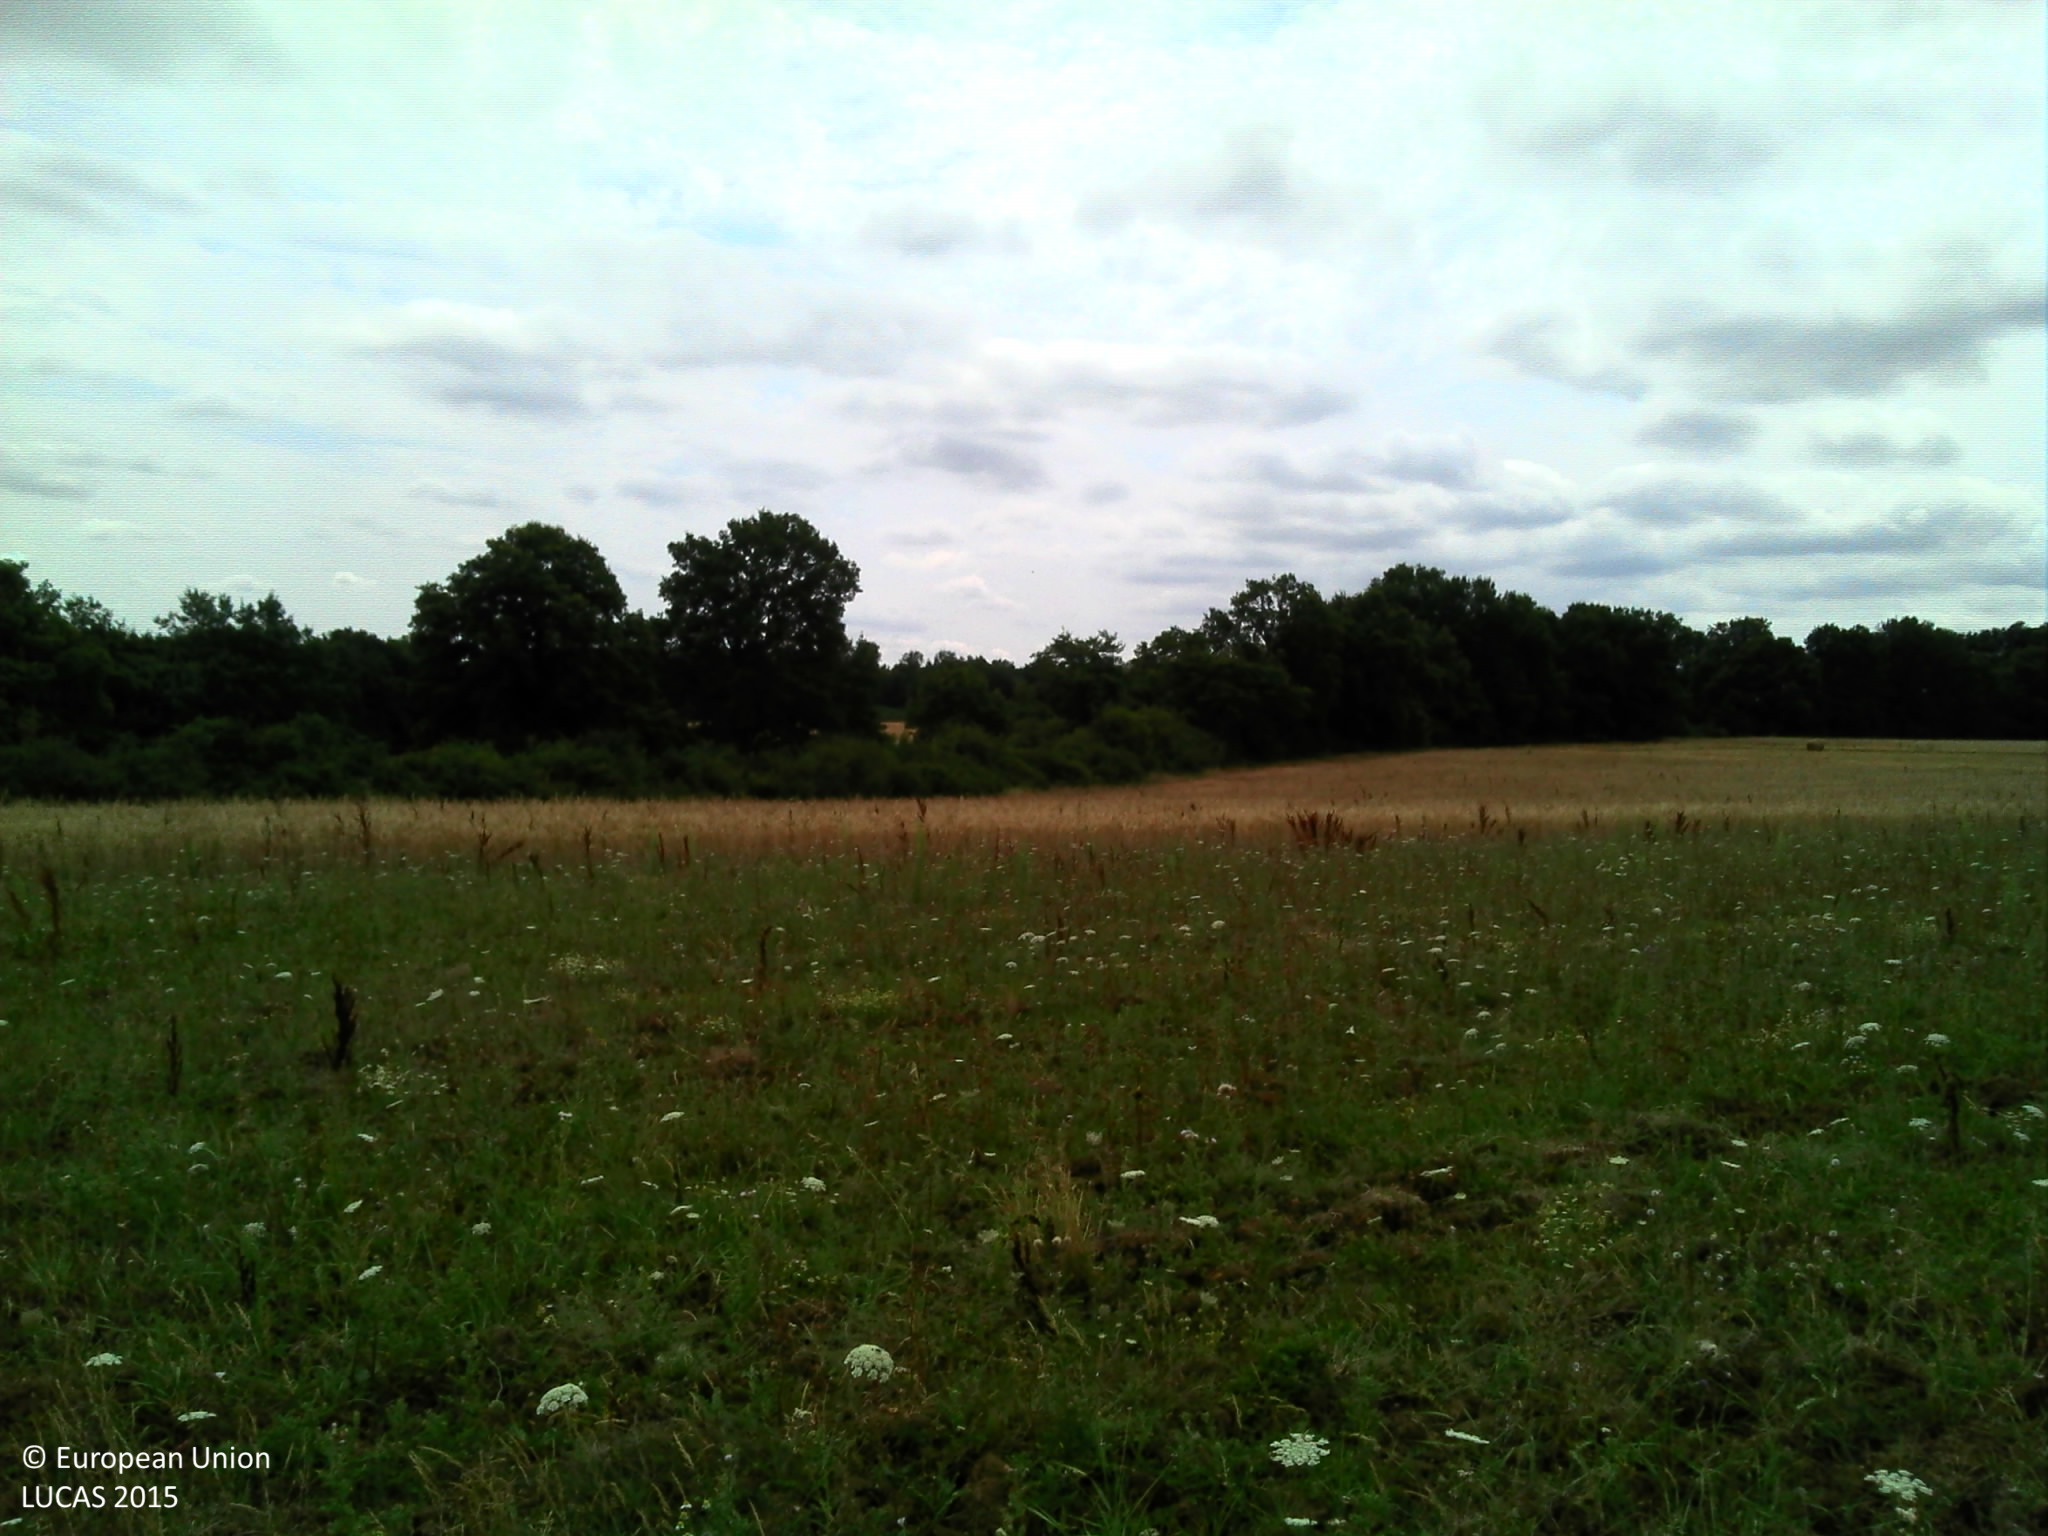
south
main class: Grassland
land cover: Spontaneously vegetated surfaces
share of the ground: > 75 %
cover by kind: herbaceous plants 100 %
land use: Fallow land
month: July
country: FR
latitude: 46.6626
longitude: 2.9784
